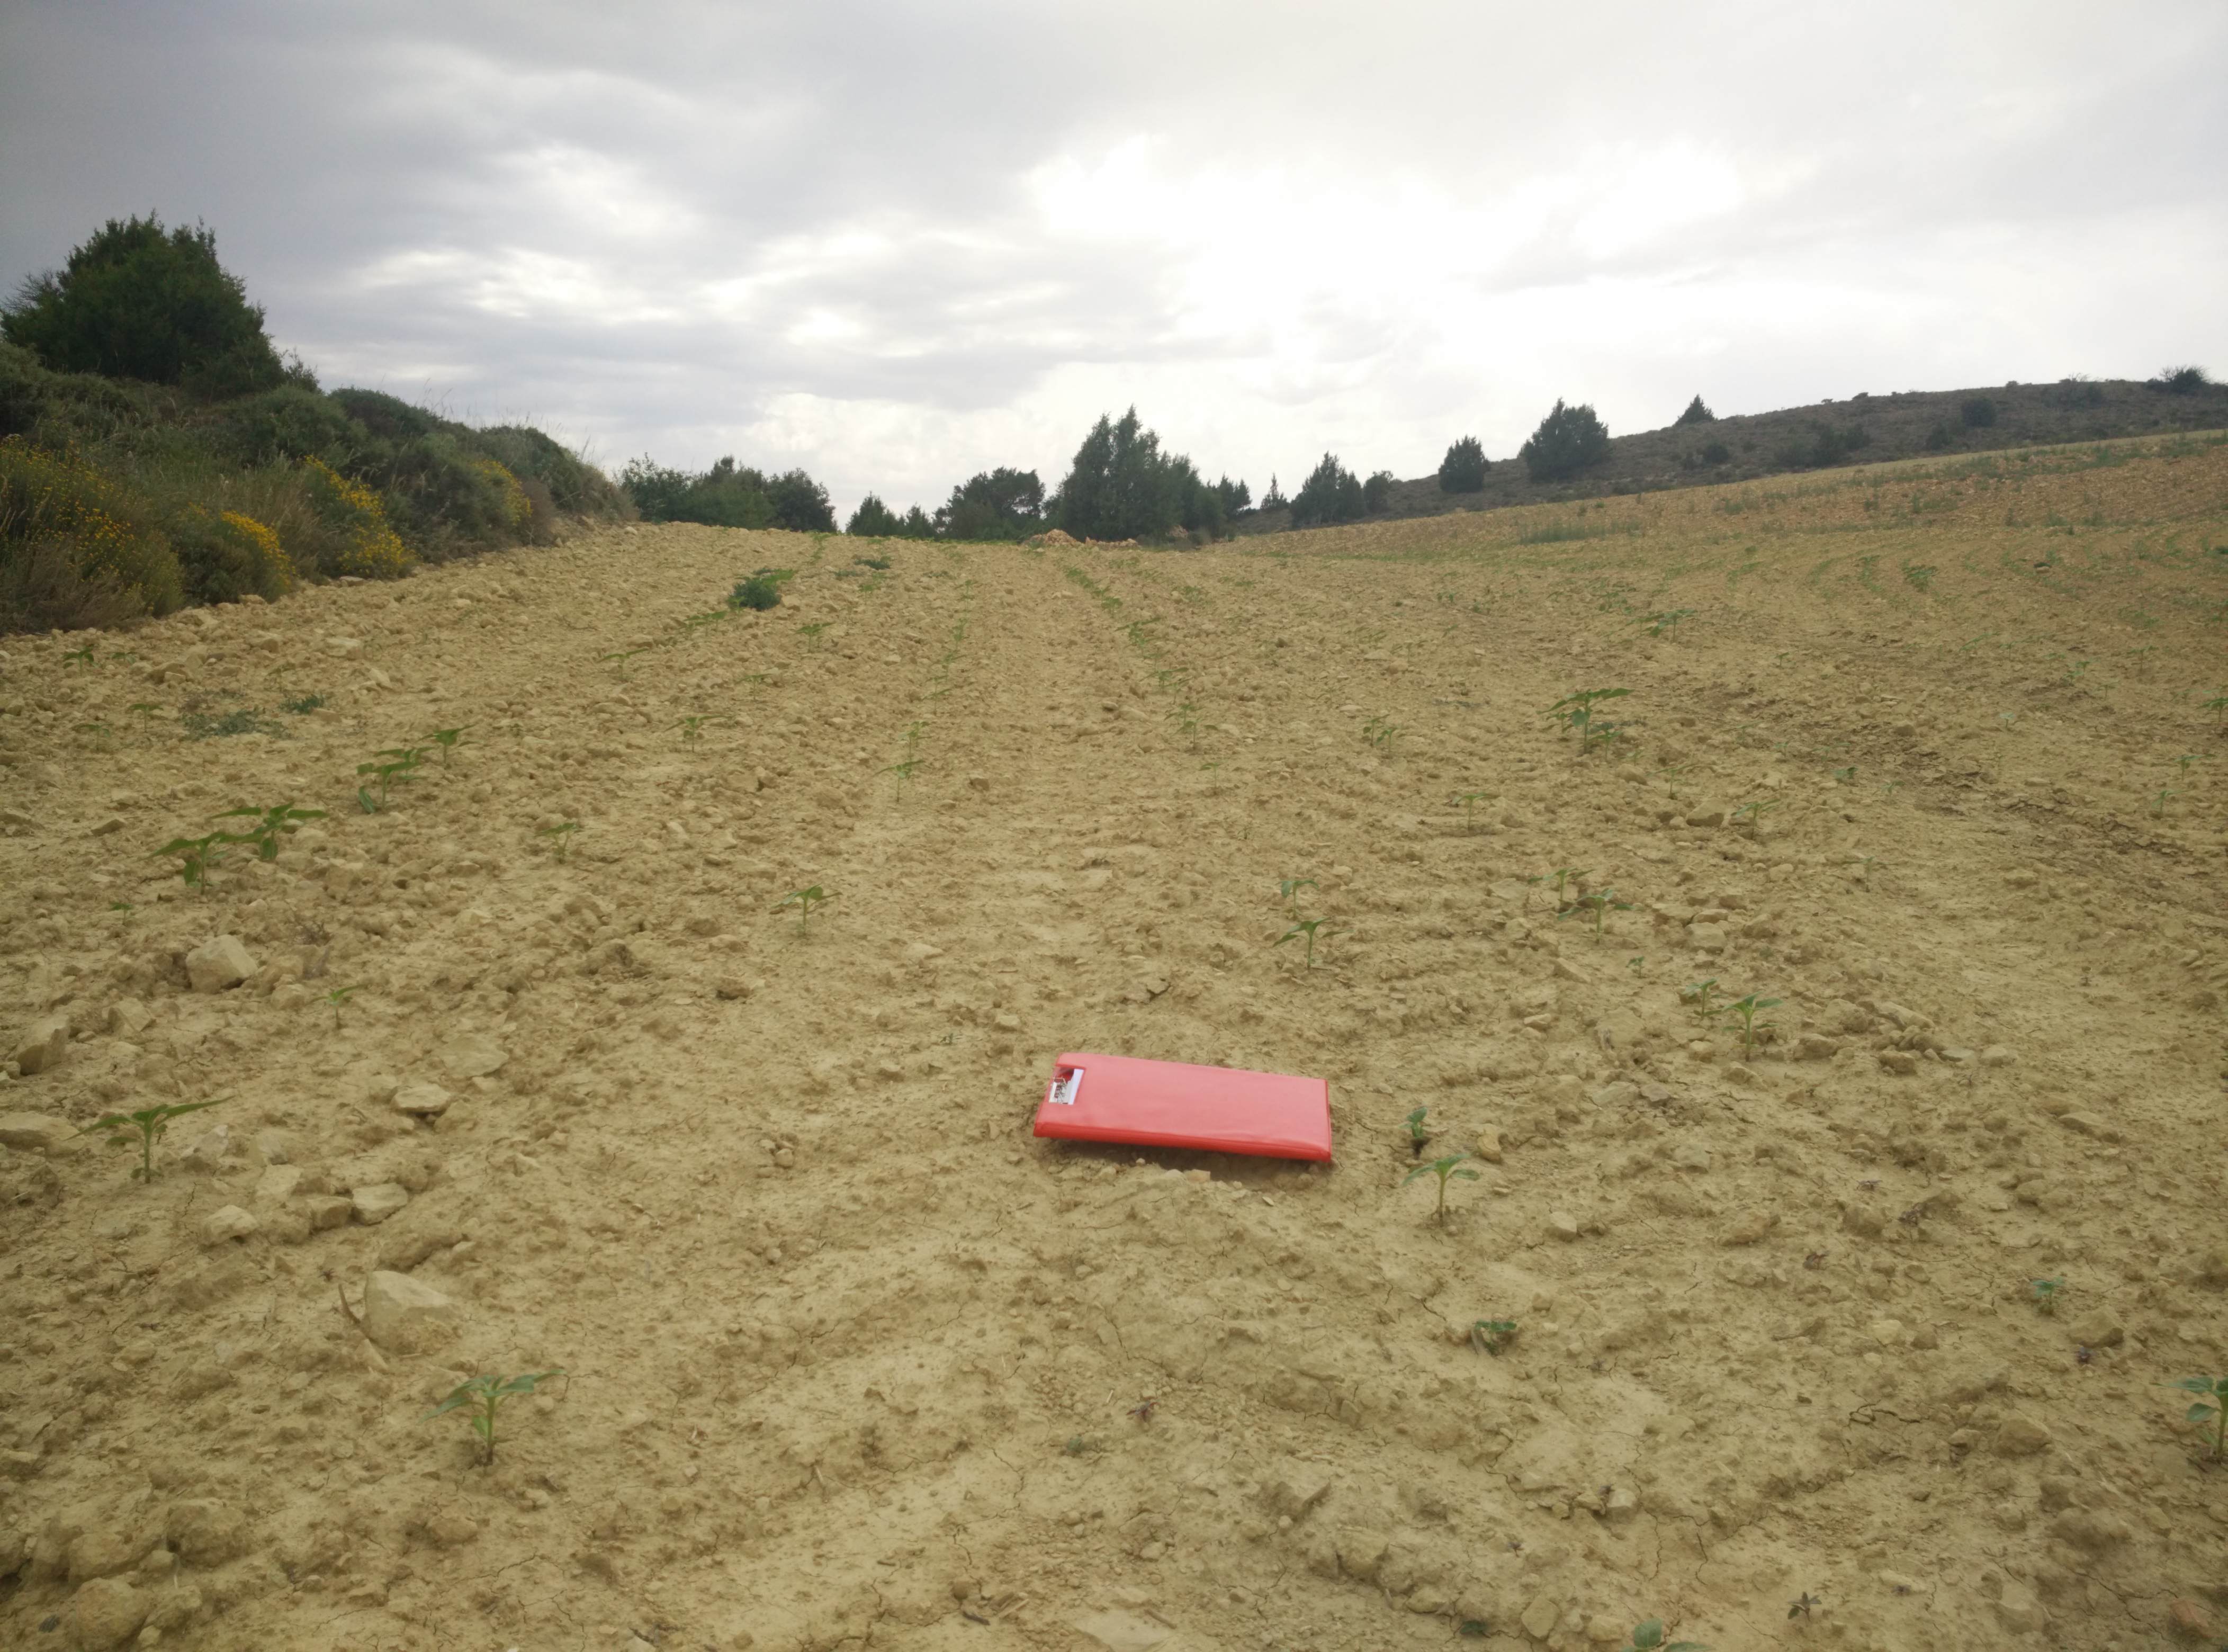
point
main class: Cropland
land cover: Sunflower
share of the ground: < 10 %
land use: Agriculture (excluding fallow land and kitchen gardens)
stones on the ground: < 10 %
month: July
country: ES
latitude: 41.0396
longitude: -1.8842
